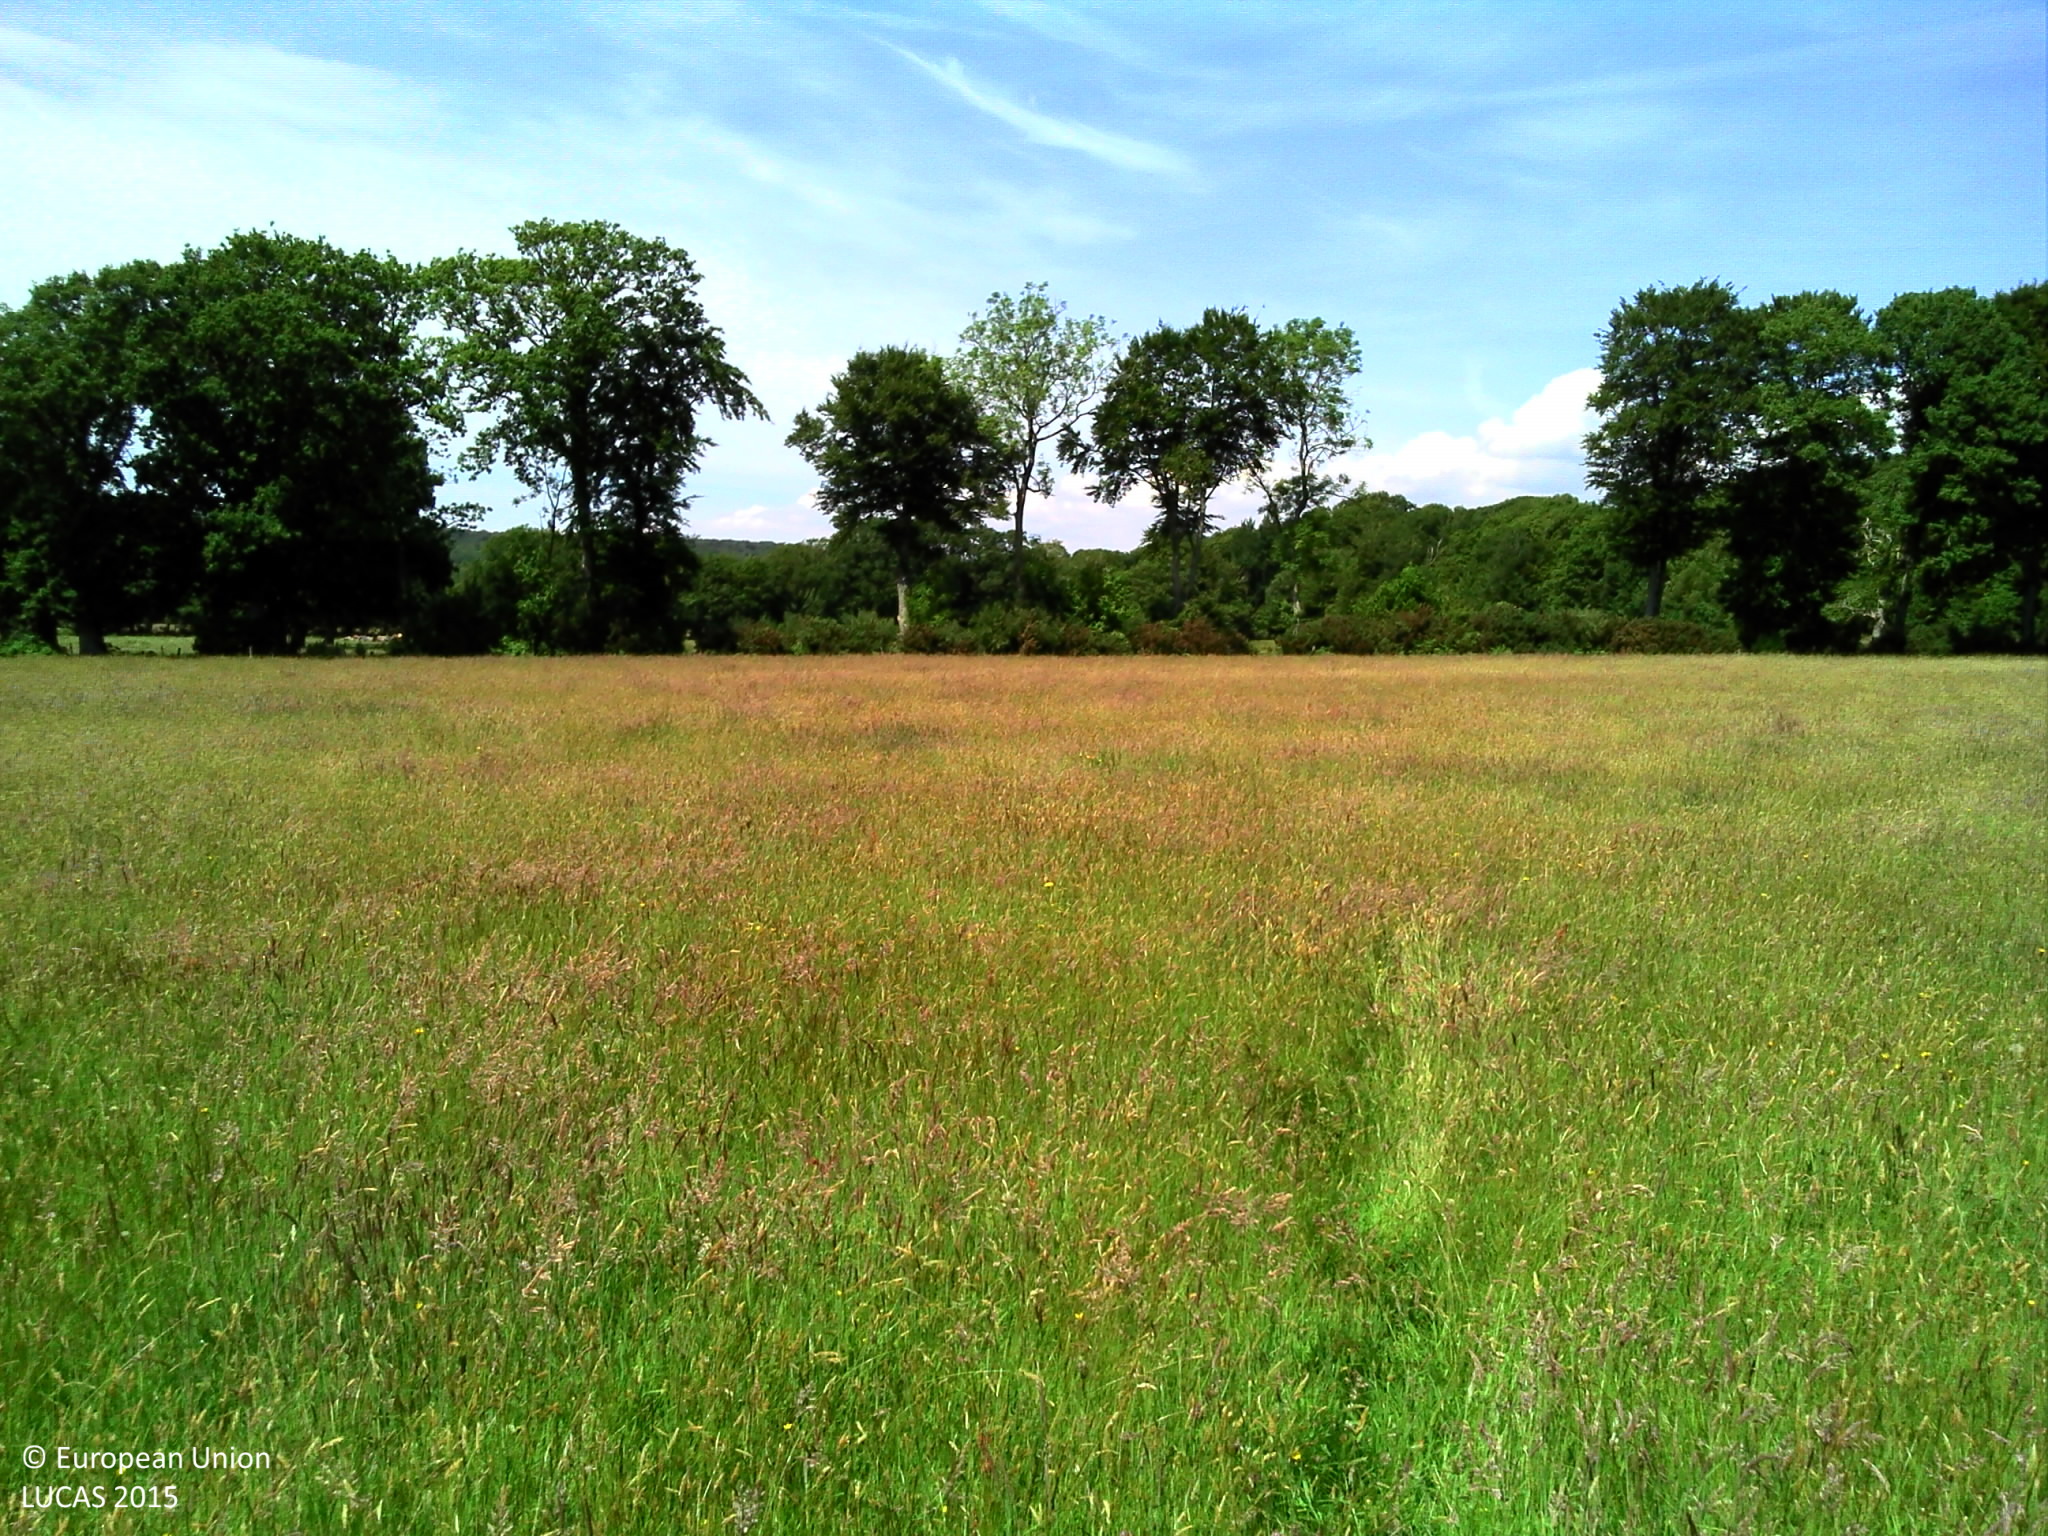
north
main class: Grassland
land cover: Grassland without tree/shrub cover
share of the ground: > 75 %
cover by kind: herbaceous plants 100 %
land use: Agriculture (excluding fallow land and kitchen gardens)
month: June
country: FR
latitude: 49.3088
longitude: -1.5065
